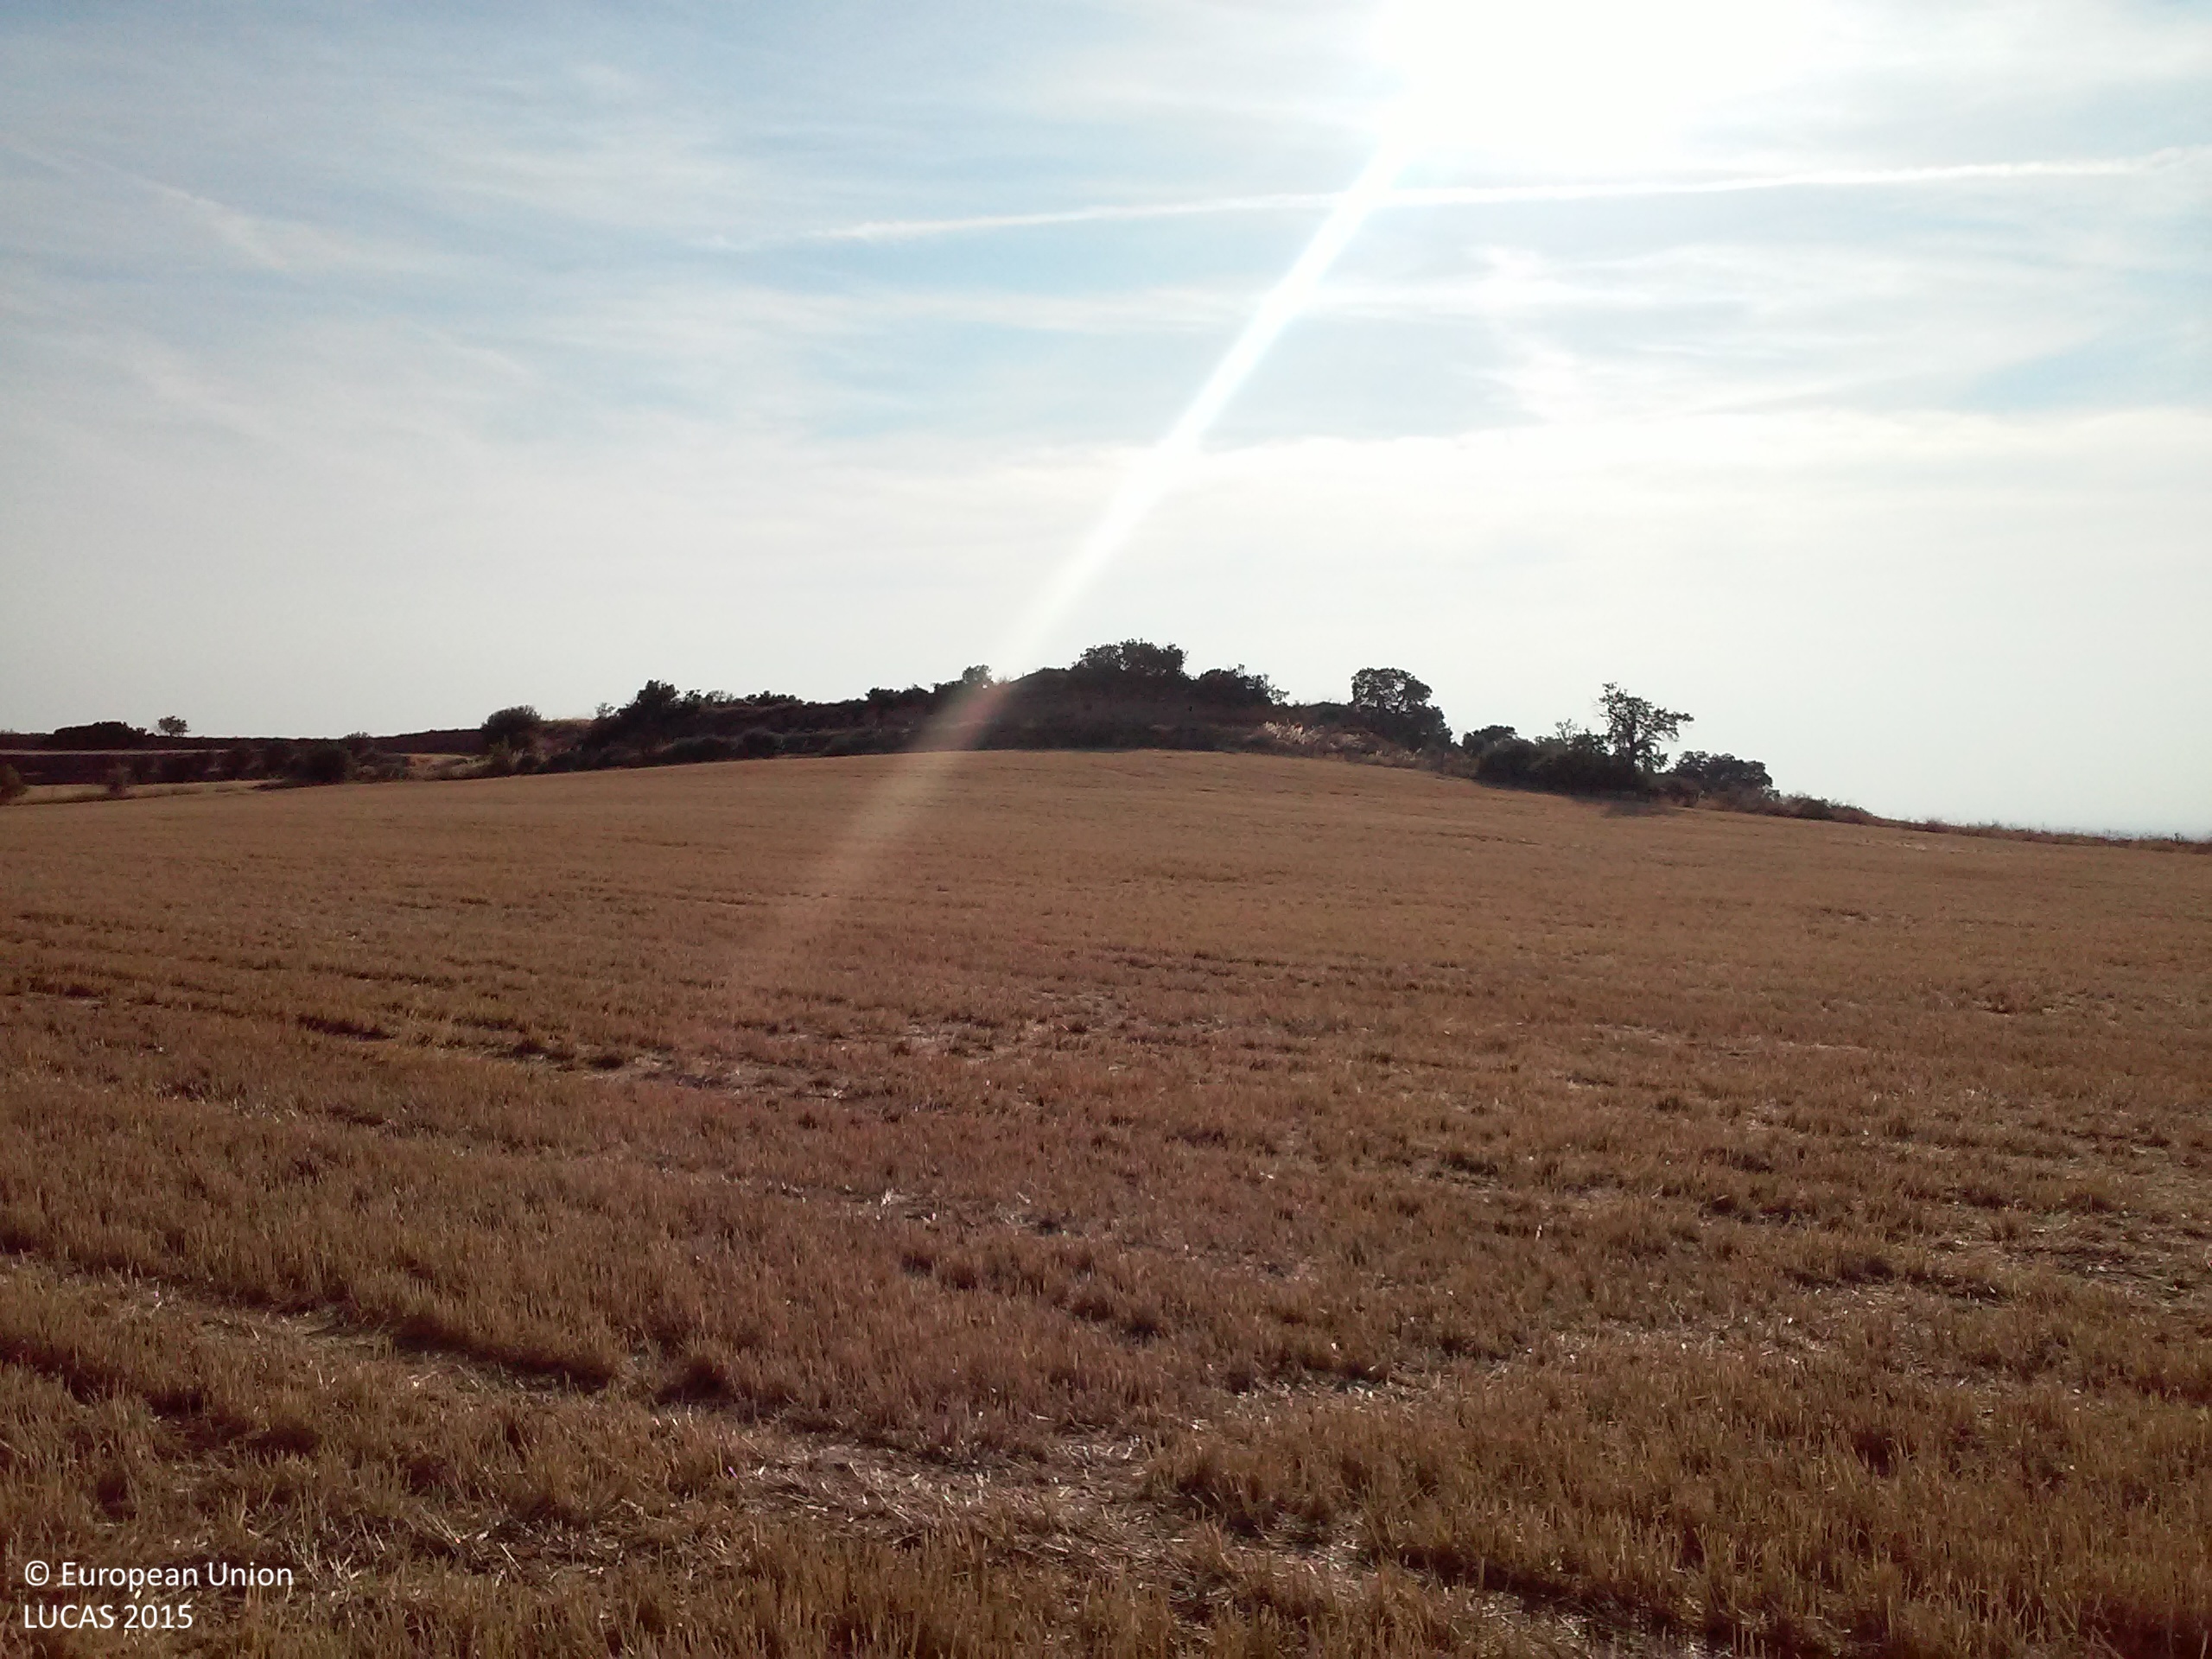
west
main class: Cropland
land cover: Barley
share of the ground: < 10 %
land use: Agriculture (excluding fallow land and kitchen gardens)
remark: Harvested field
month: July
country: ES
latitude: 41.6138
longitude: 1.1695
